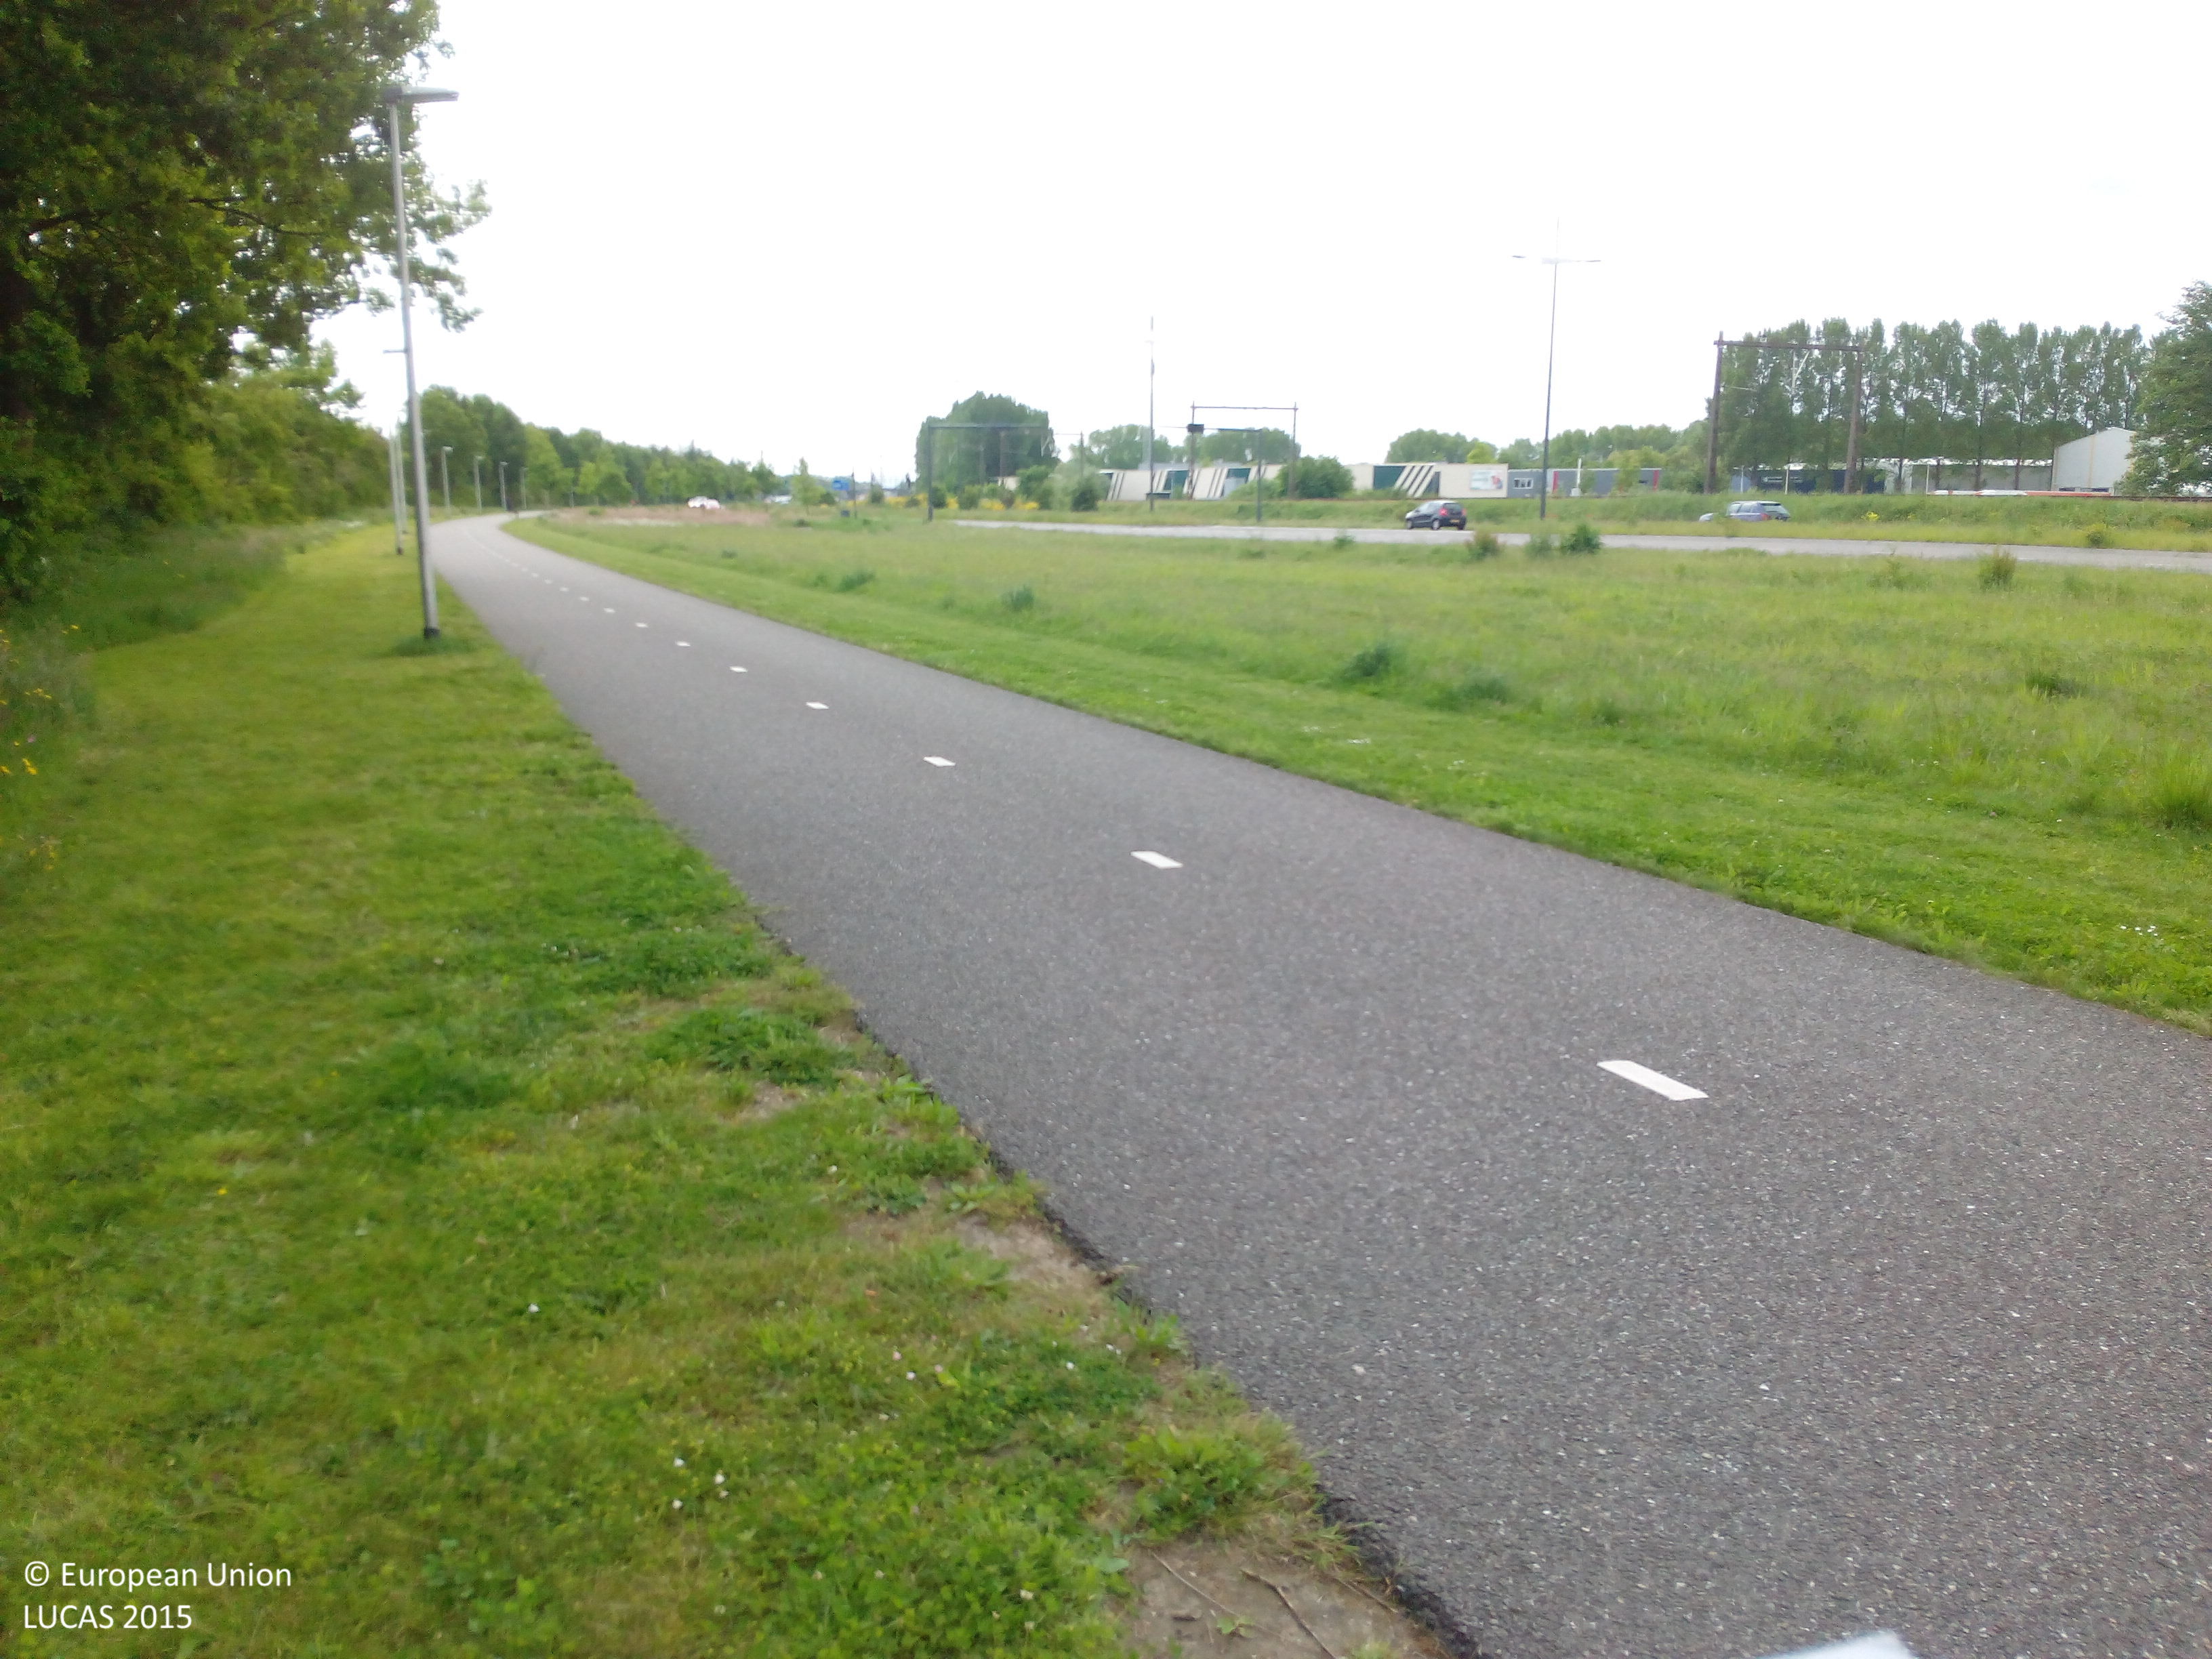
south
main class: Grassland
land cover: Grassland without tree/shrub cover
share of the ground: > 75 %
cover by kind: herbaceous plants 100 %
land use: Road transport
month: May
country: NL
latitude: 52.2449
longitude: 6.2061
